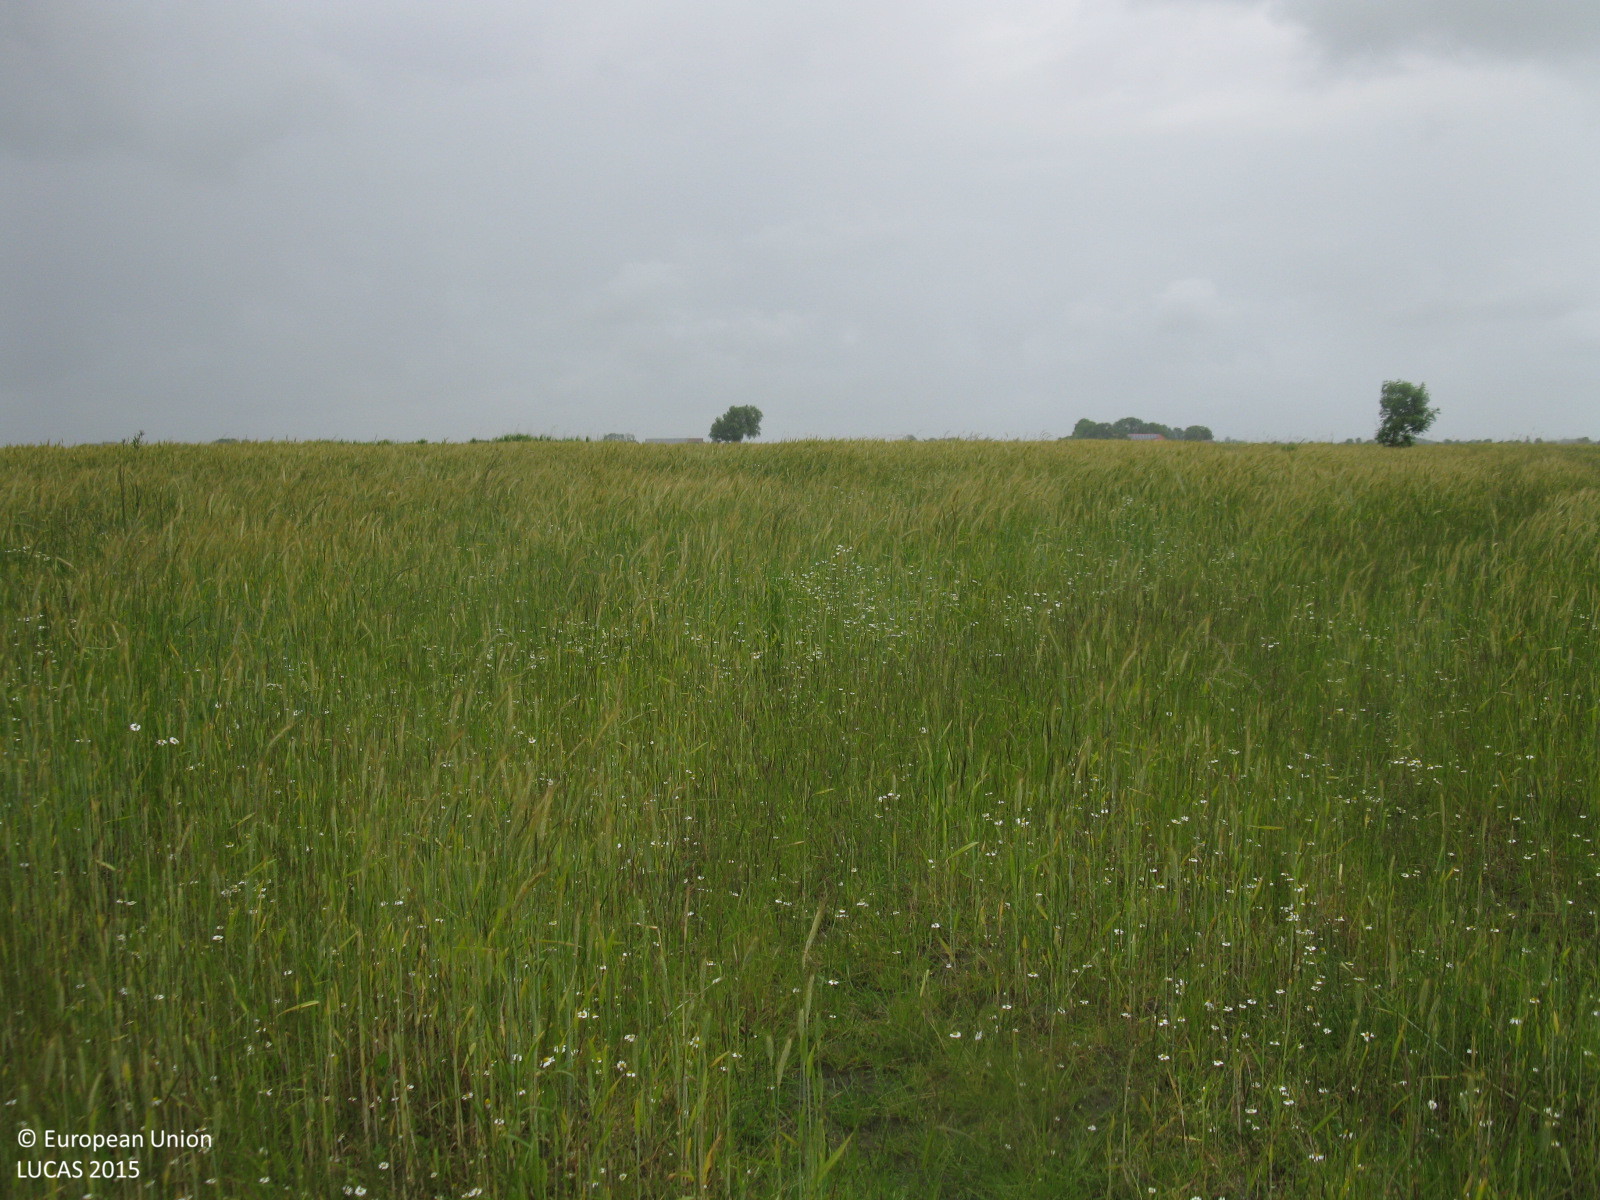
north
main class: Cropland
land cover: Triticale
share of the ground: > 75 %
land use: Agriculture (excluding fallow land and kitchen gardens)
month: June
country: DE
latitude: 53.6724
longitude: 7.9573
